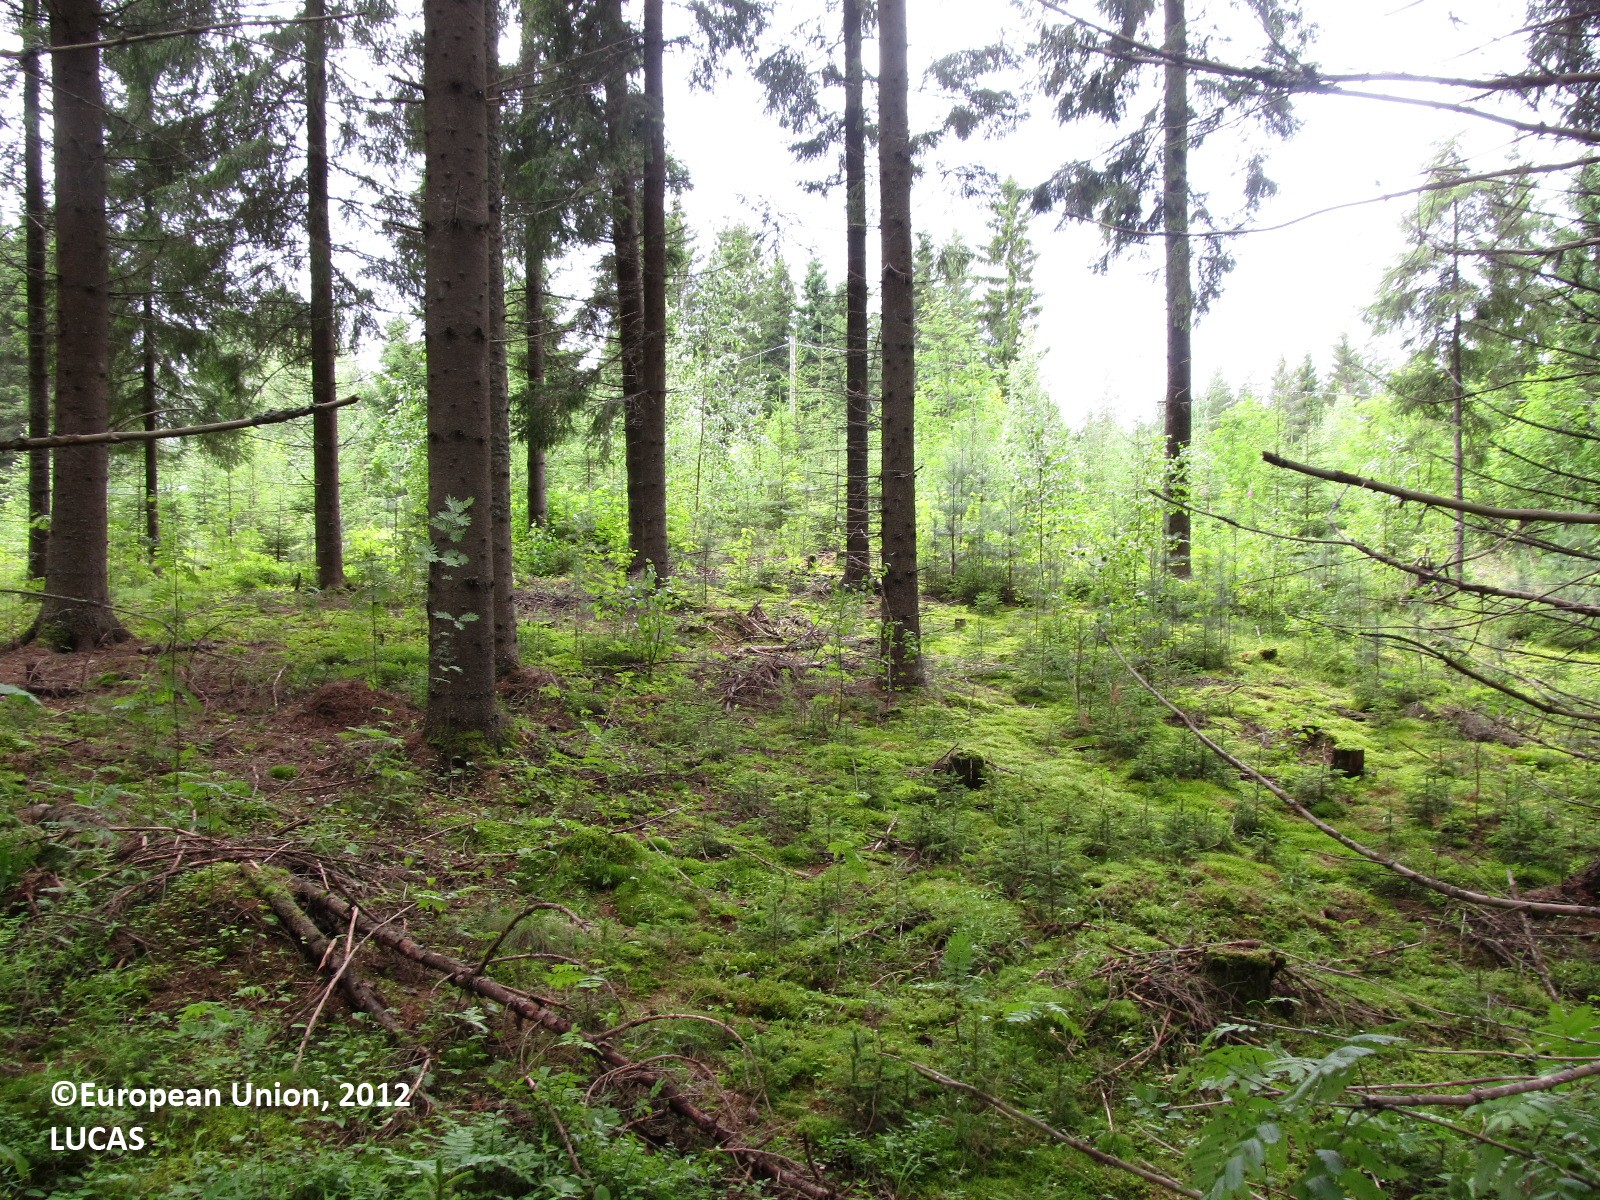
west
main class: Woodland
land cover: Spruce dominated coniferous woodland
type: boreal forest
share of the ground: 50 - 75 %
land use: Forestry
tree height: > 5 m
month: July
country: FI
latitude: 61.8989
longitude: 29.0499
